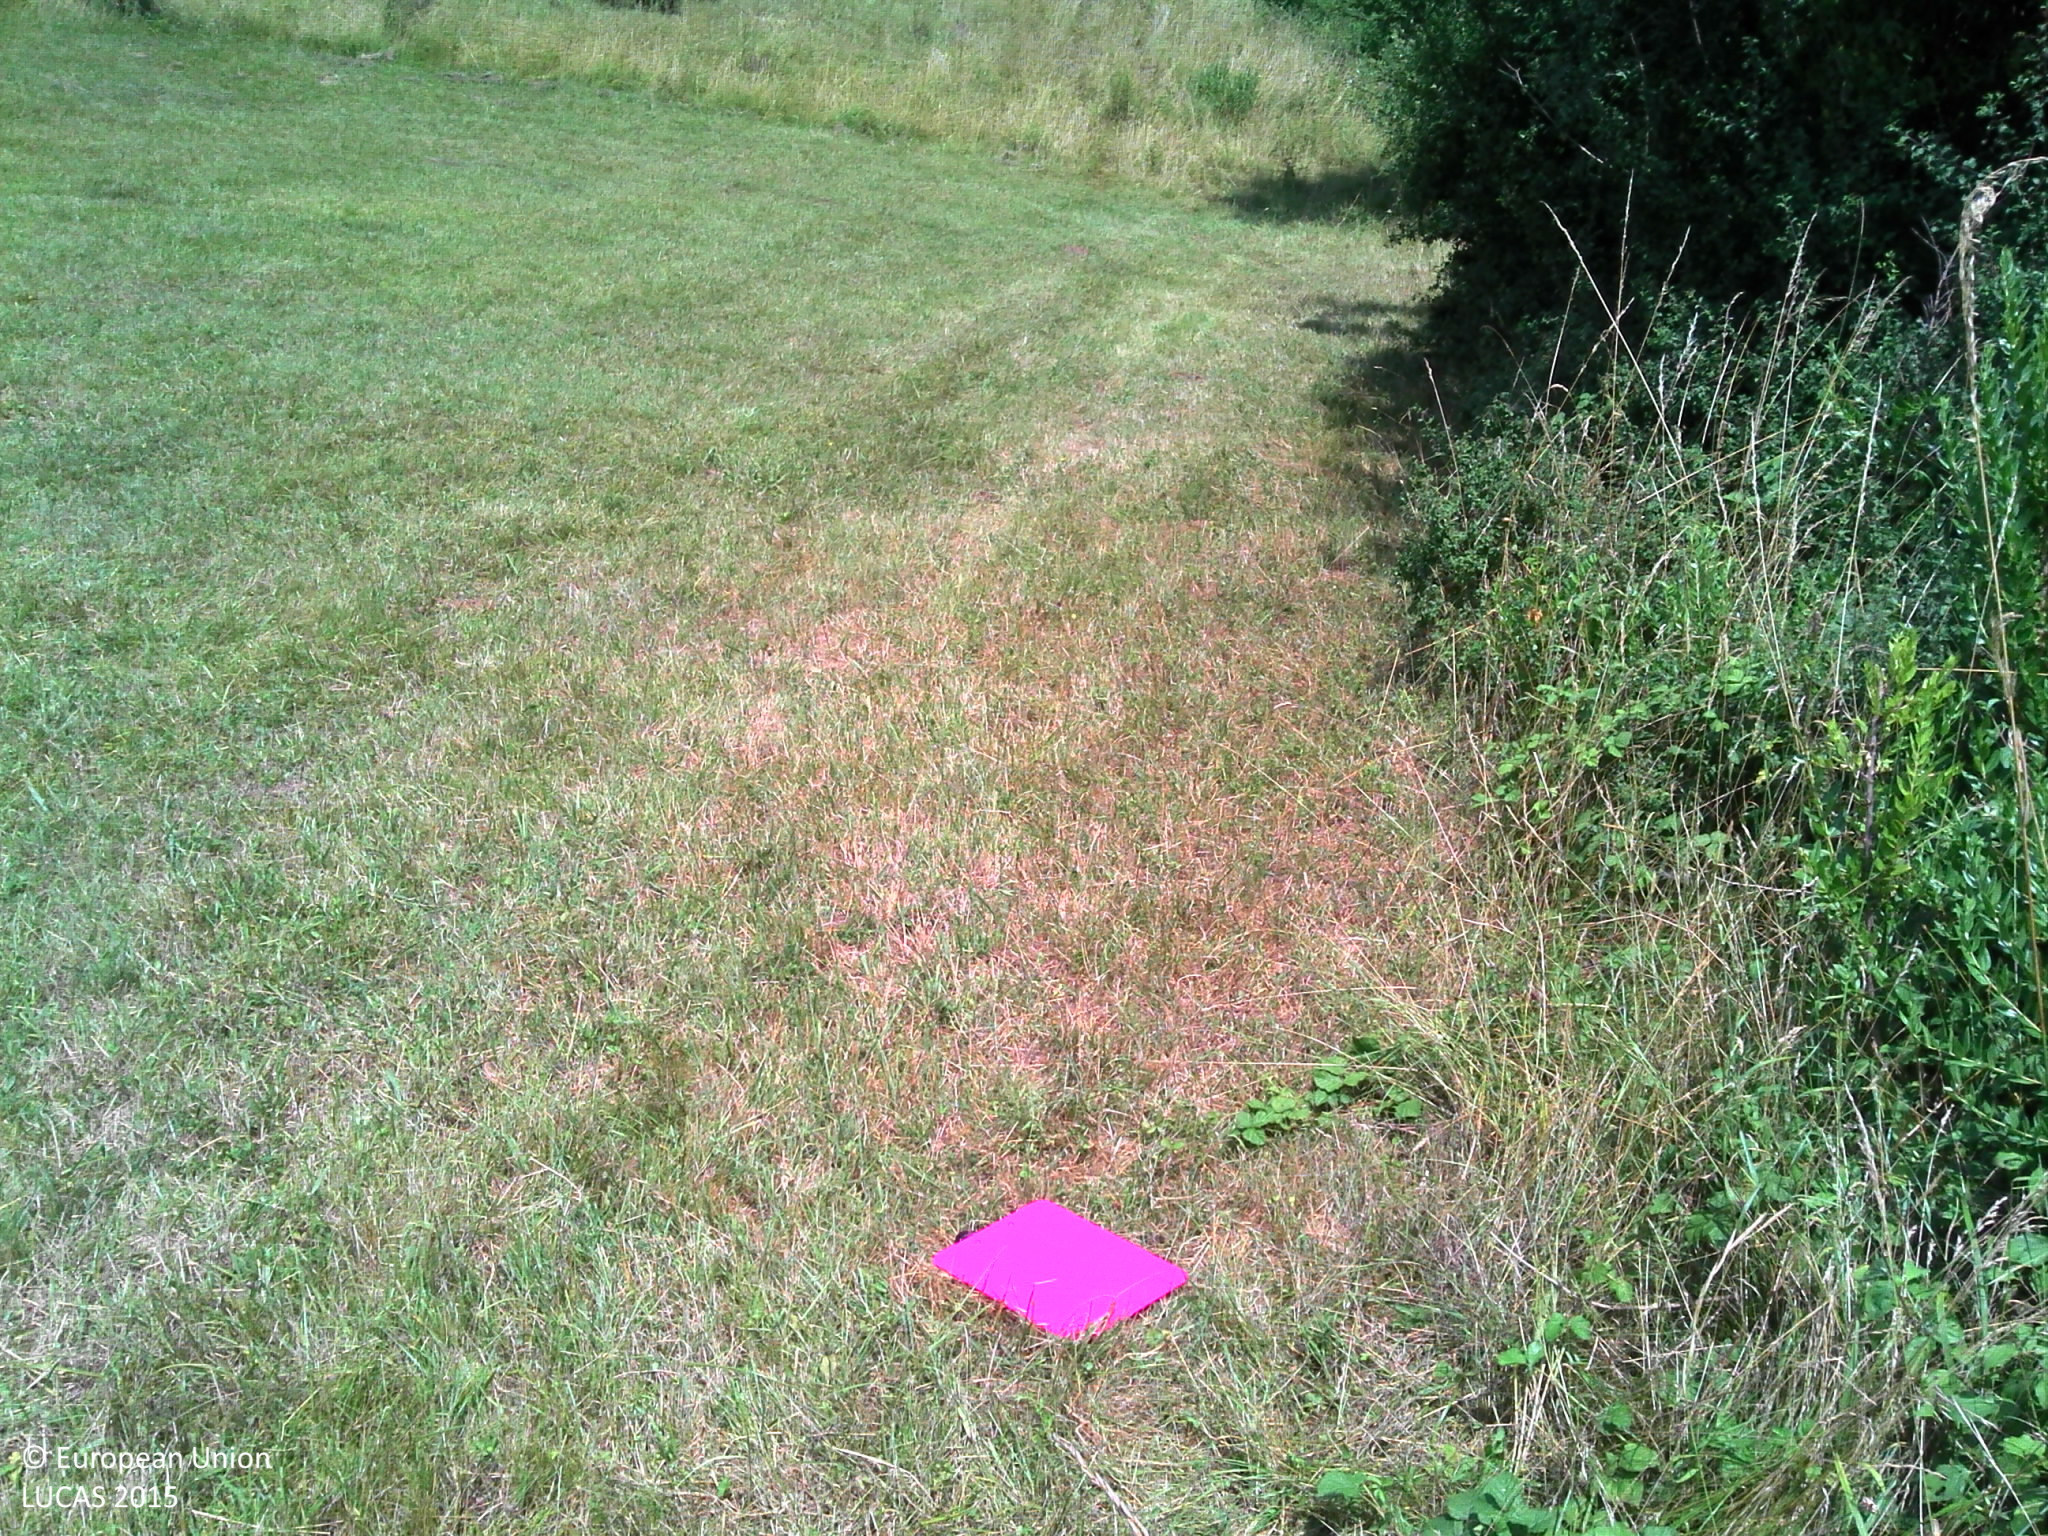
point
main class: Grassland
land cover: Grassland without tree/shrub cover
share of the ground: > 75 %
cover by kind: herbaceous plants 100 %
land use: Agriculture (excluding fallow land and kitchen gardens)
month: July
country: FR
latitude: 43.0878
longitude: 1.4187
